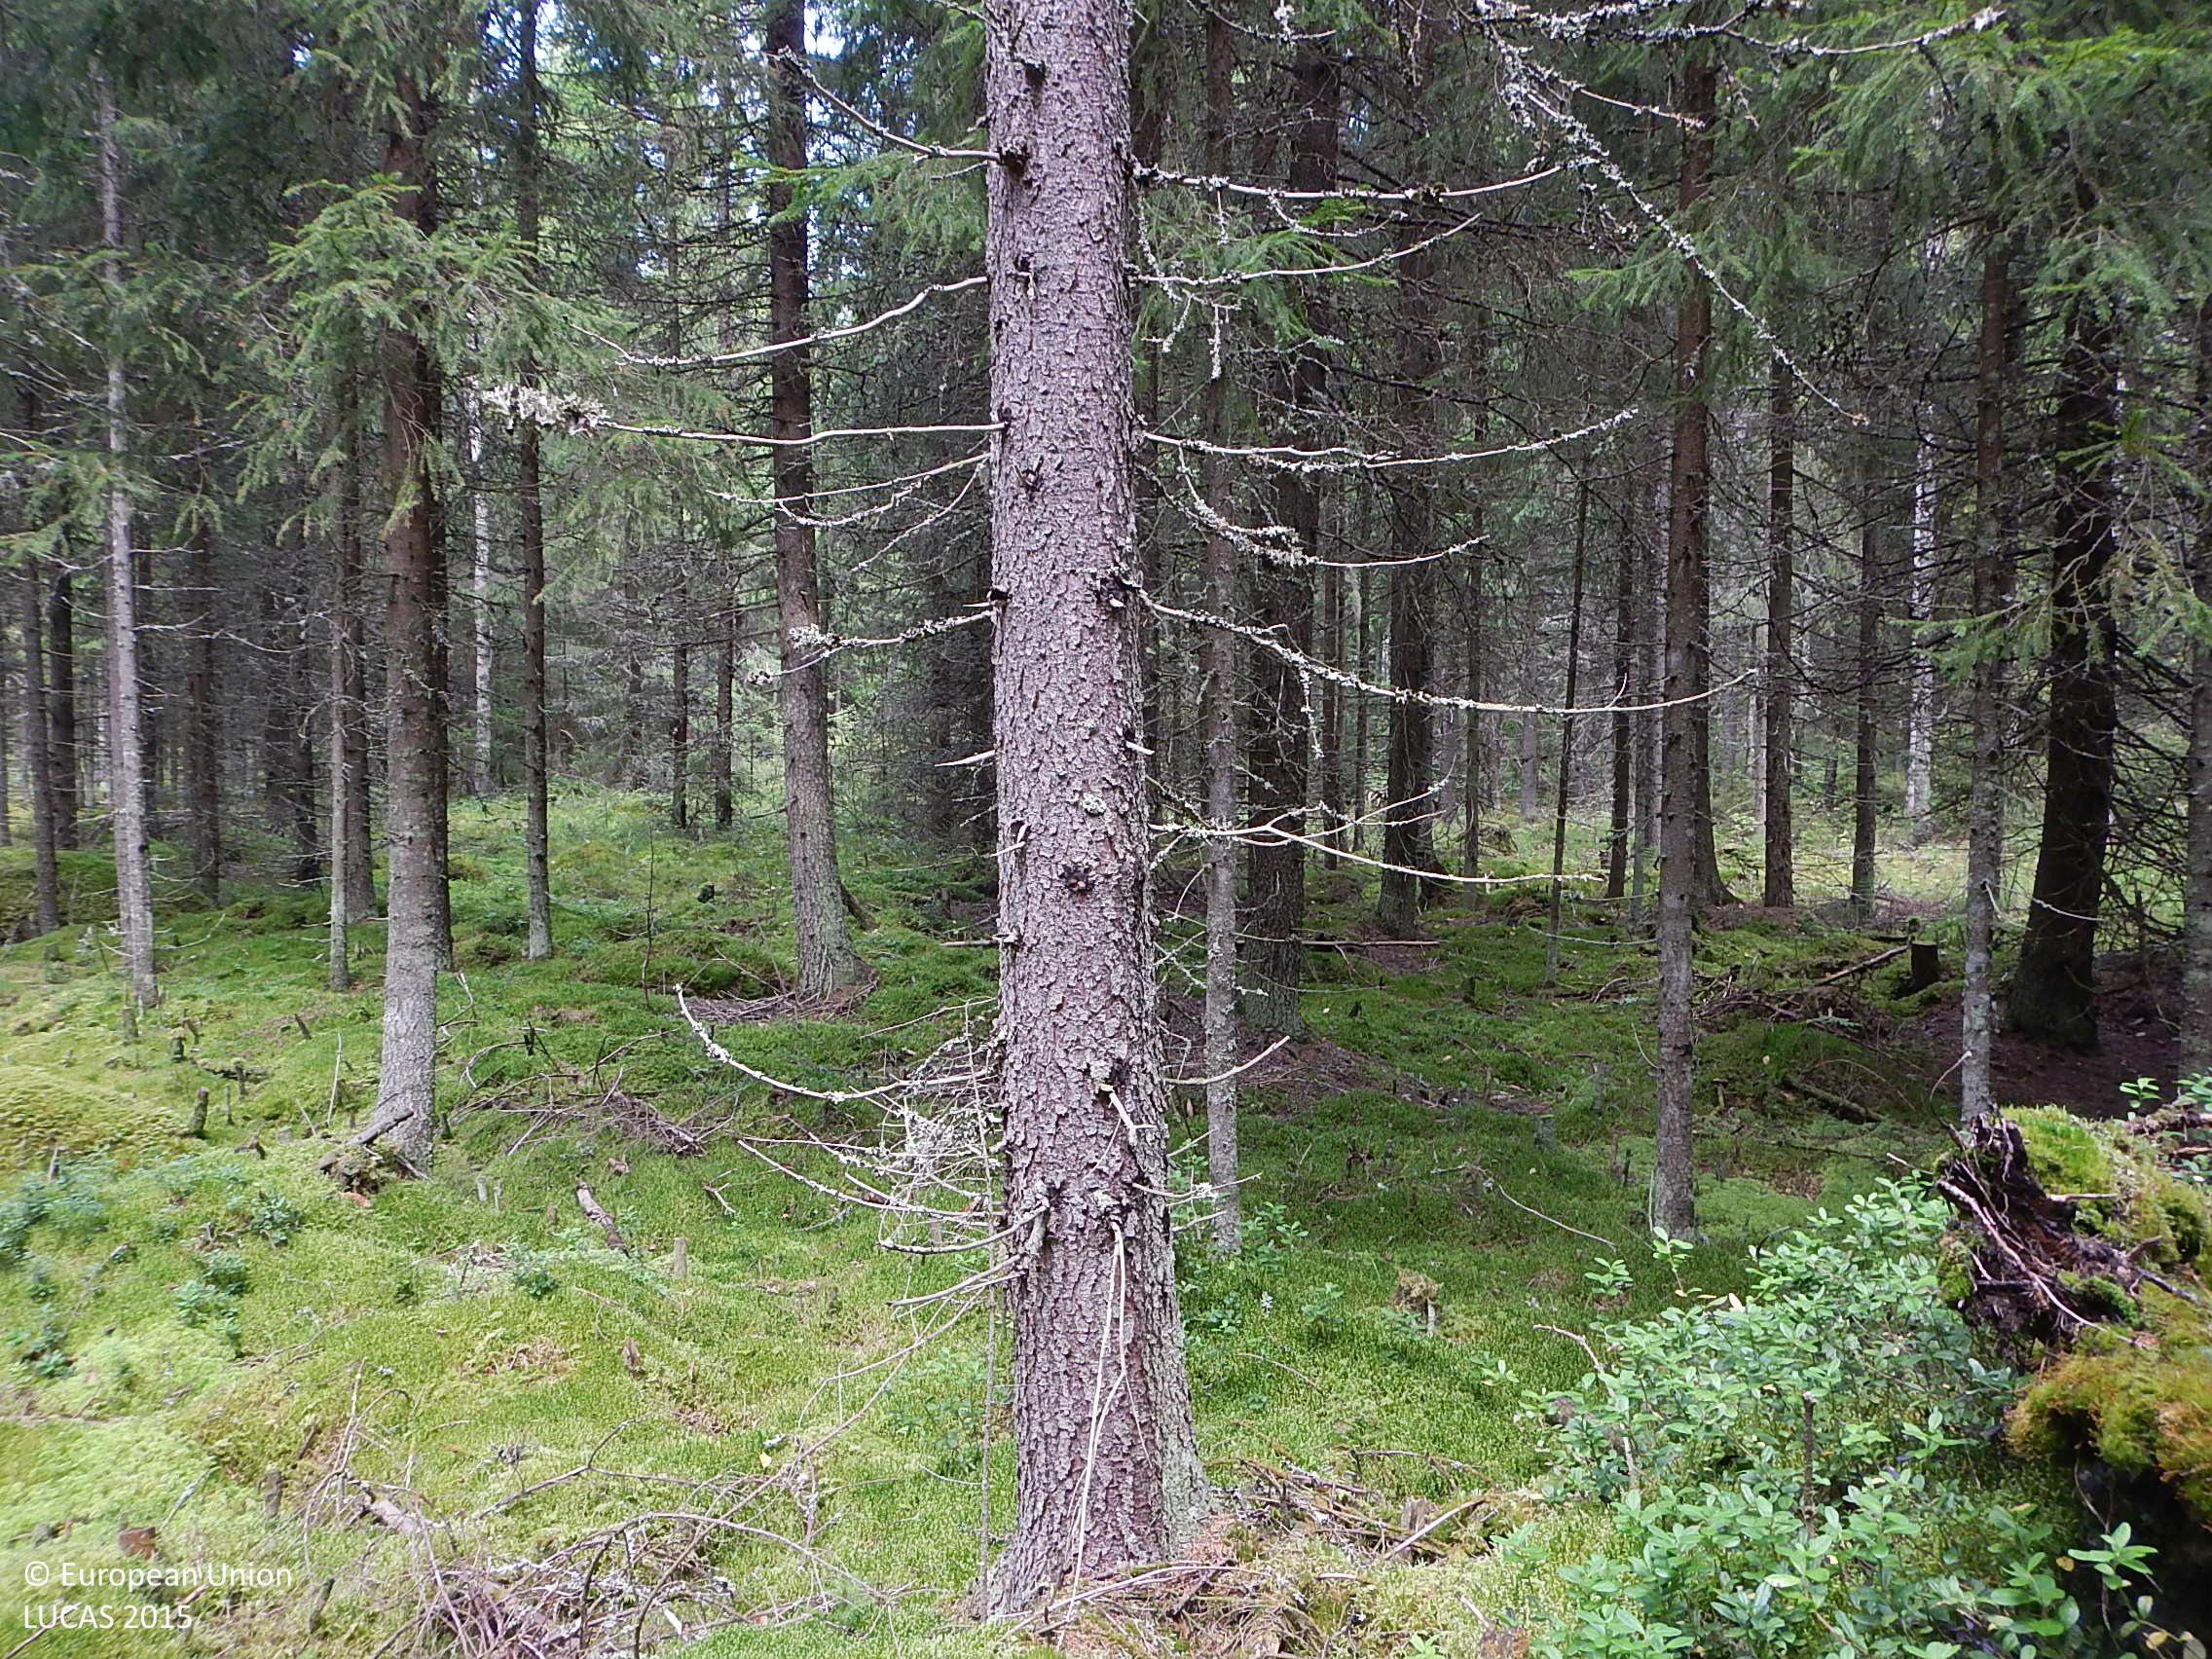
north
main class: Woodland
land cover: Spruce dominated coniferous woodland
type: boreal forest
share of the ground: > 75 %
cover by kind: coniferous forest trees 75 %, lichens and mosses 20 %, herbaceous plants 5 %
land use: Forestry
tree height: > 5 m
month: September
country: FI
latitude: 61.3918
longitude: 22.0967
